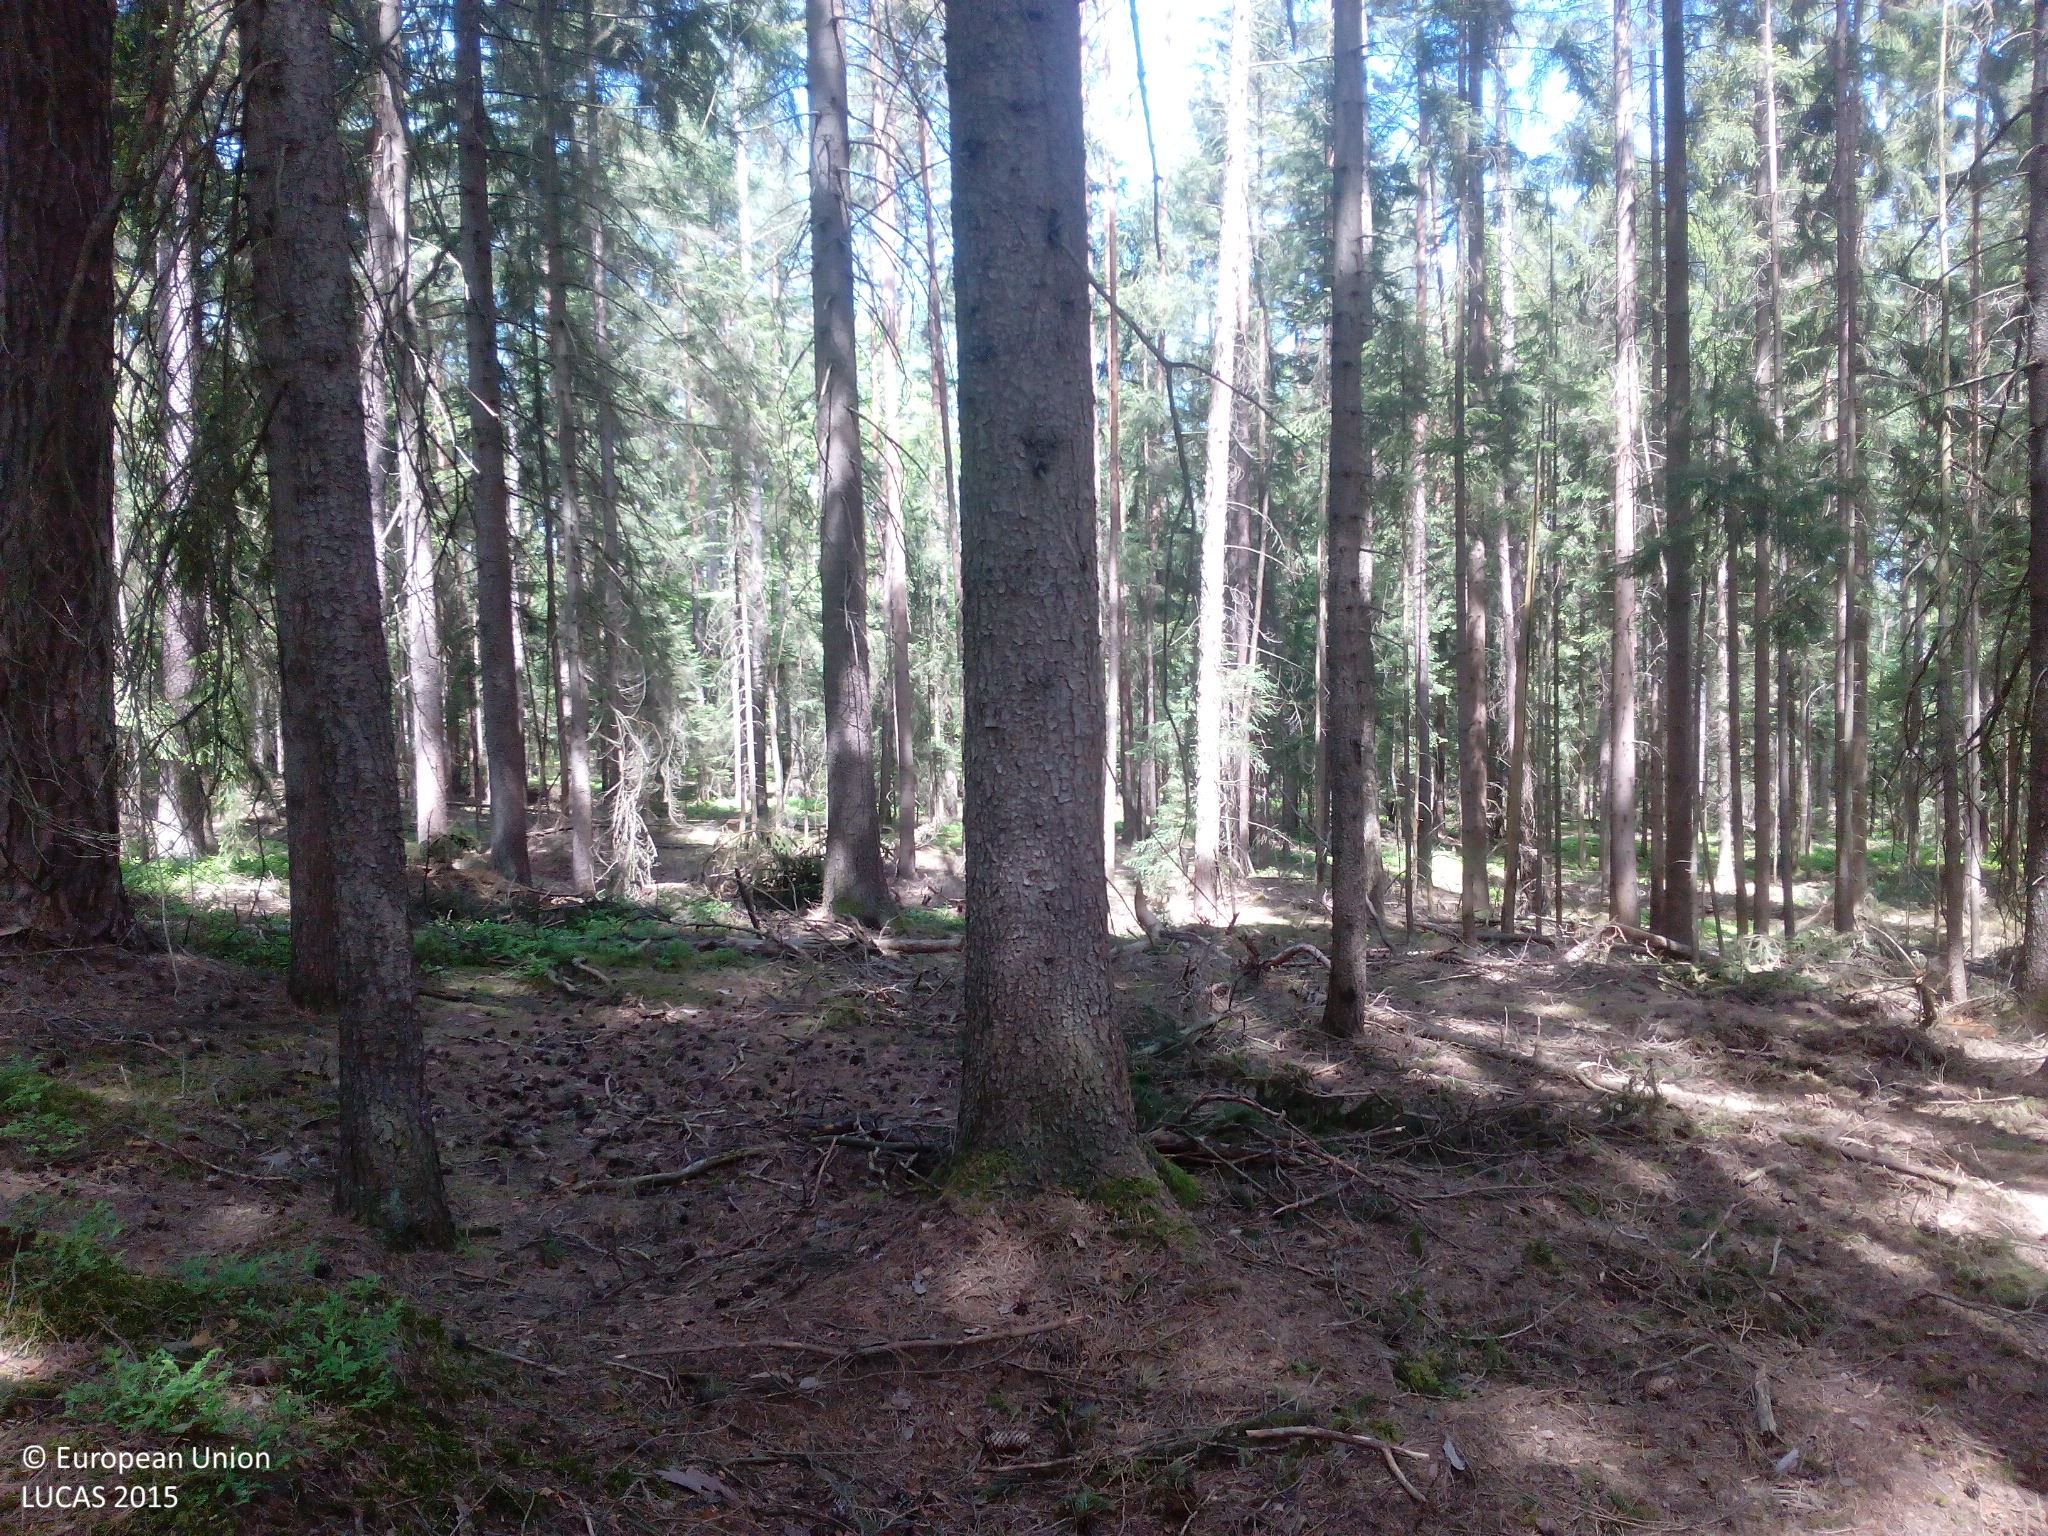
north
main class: Woodland
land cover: Spruce dominated coniferous woodland
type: hemiboreal forest and nemoral coniferous forest and mixed broadleaved-coniferous forest
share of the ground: > 75 %
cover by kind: coniferous forest trees 95 %, consolidated bare surface 5 %
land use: Forestry
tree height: > 5 m
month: May
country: DE
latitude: 49.9950
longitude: 11.4643
